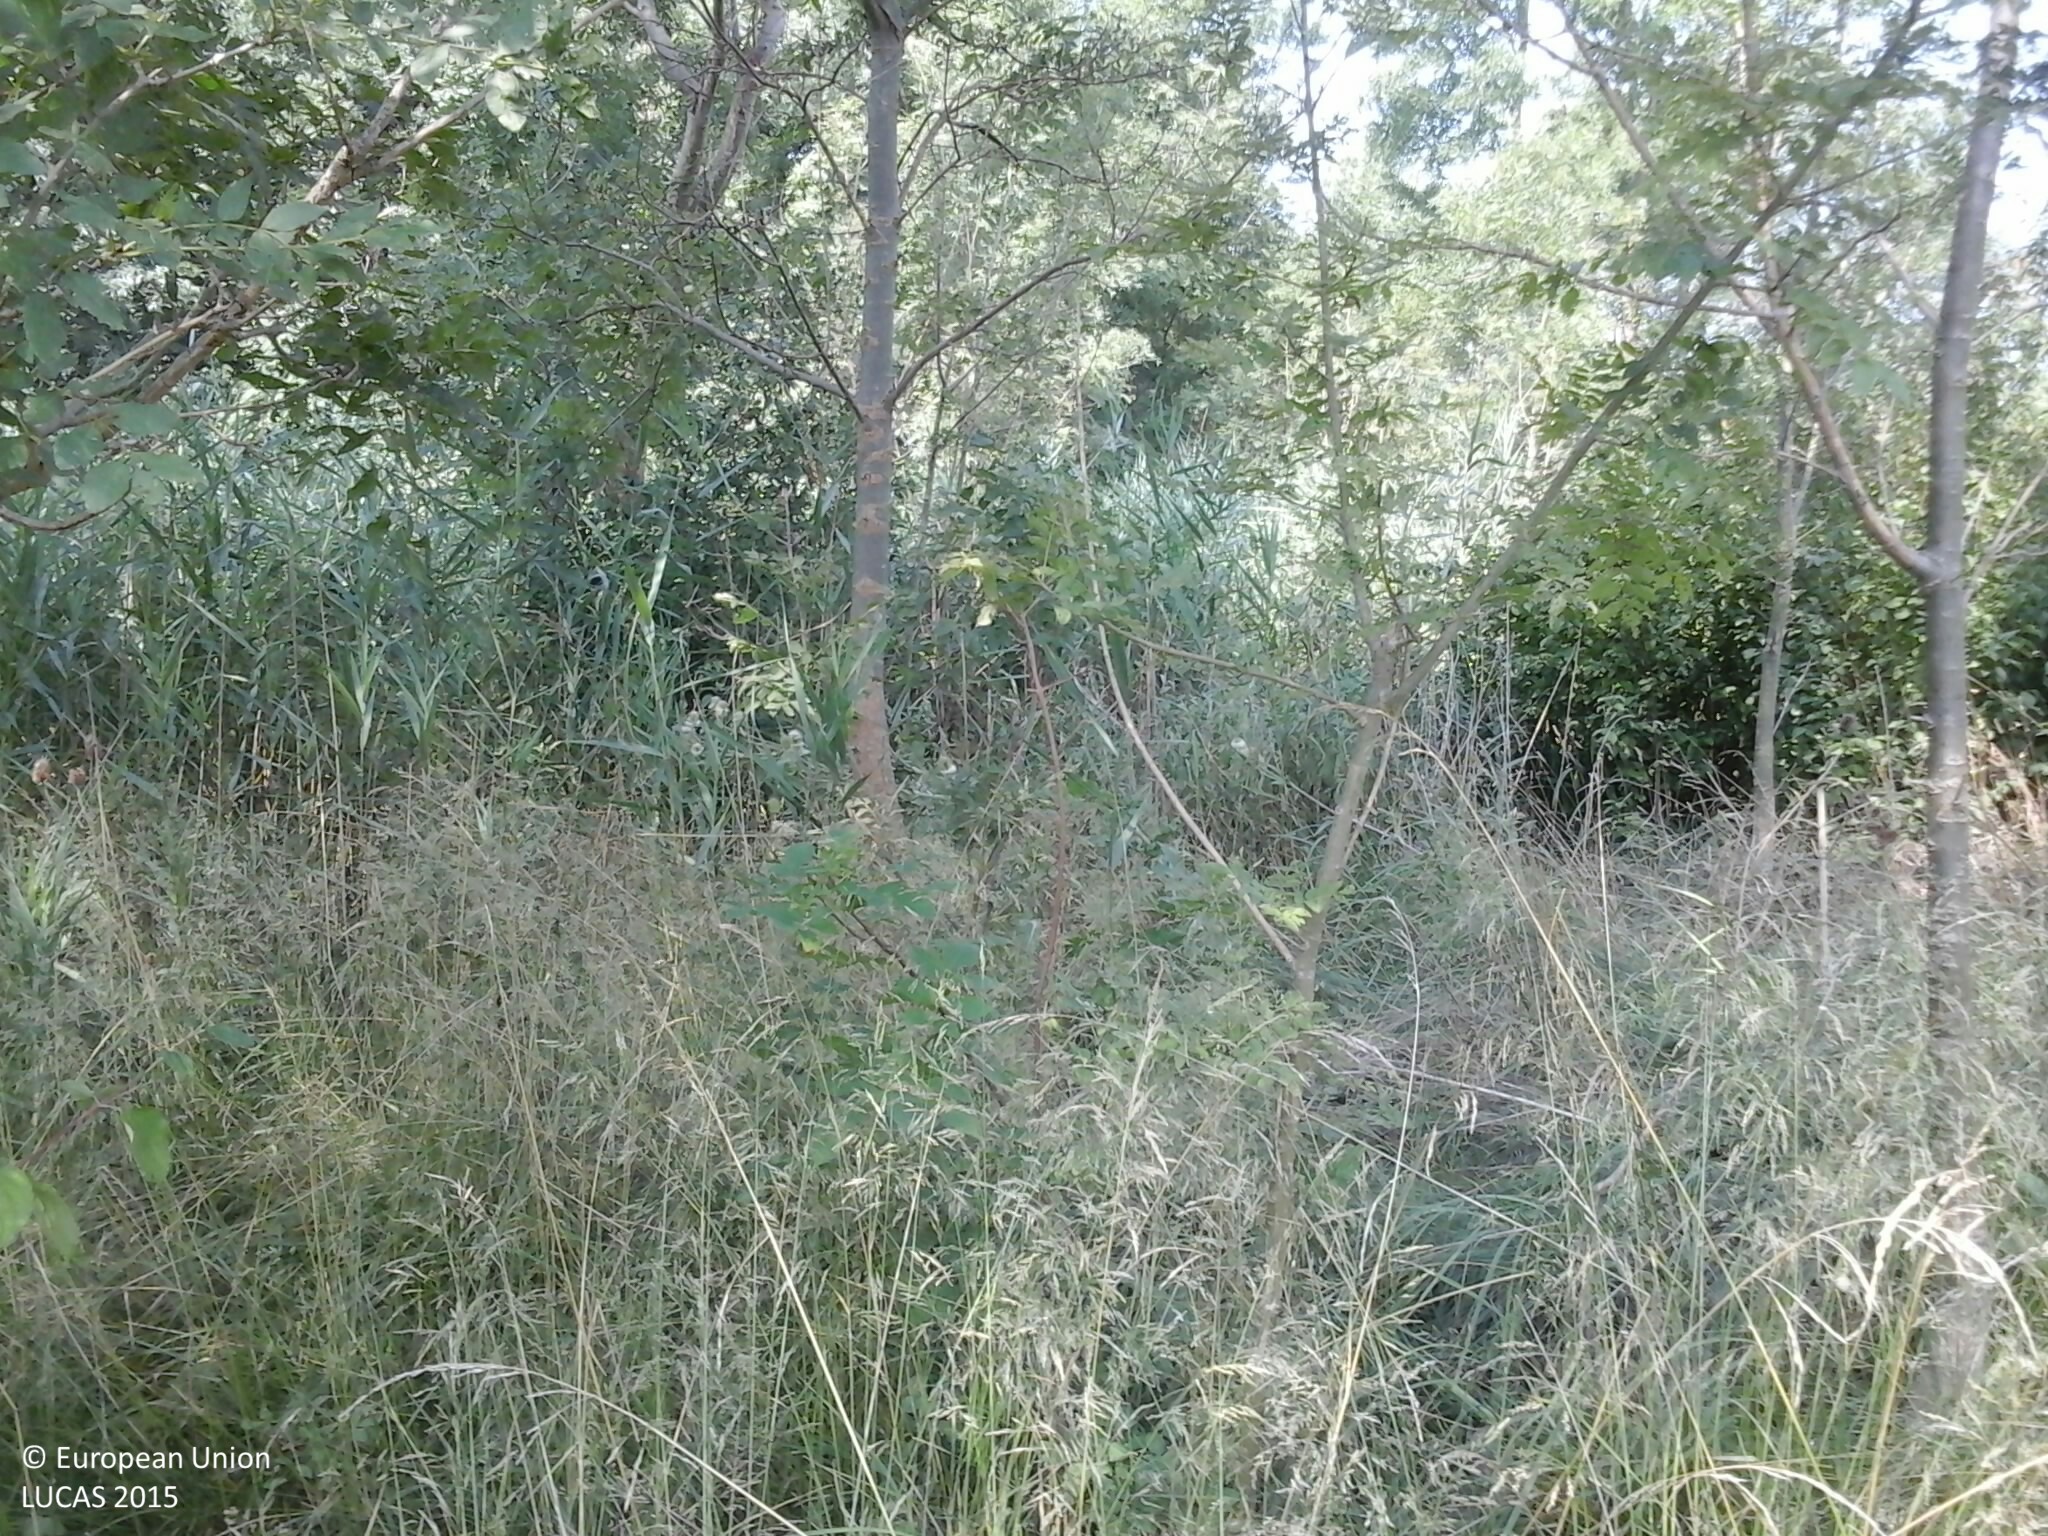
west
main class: Woodland
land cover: Broadleaved woodland
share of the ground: 25 - 50 %
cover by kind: herbaceous plants 60 %, broadleaved forest trees 40 %
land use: Abandoned areas
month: August
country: HU
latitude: 46.0391
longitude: 18.1601
